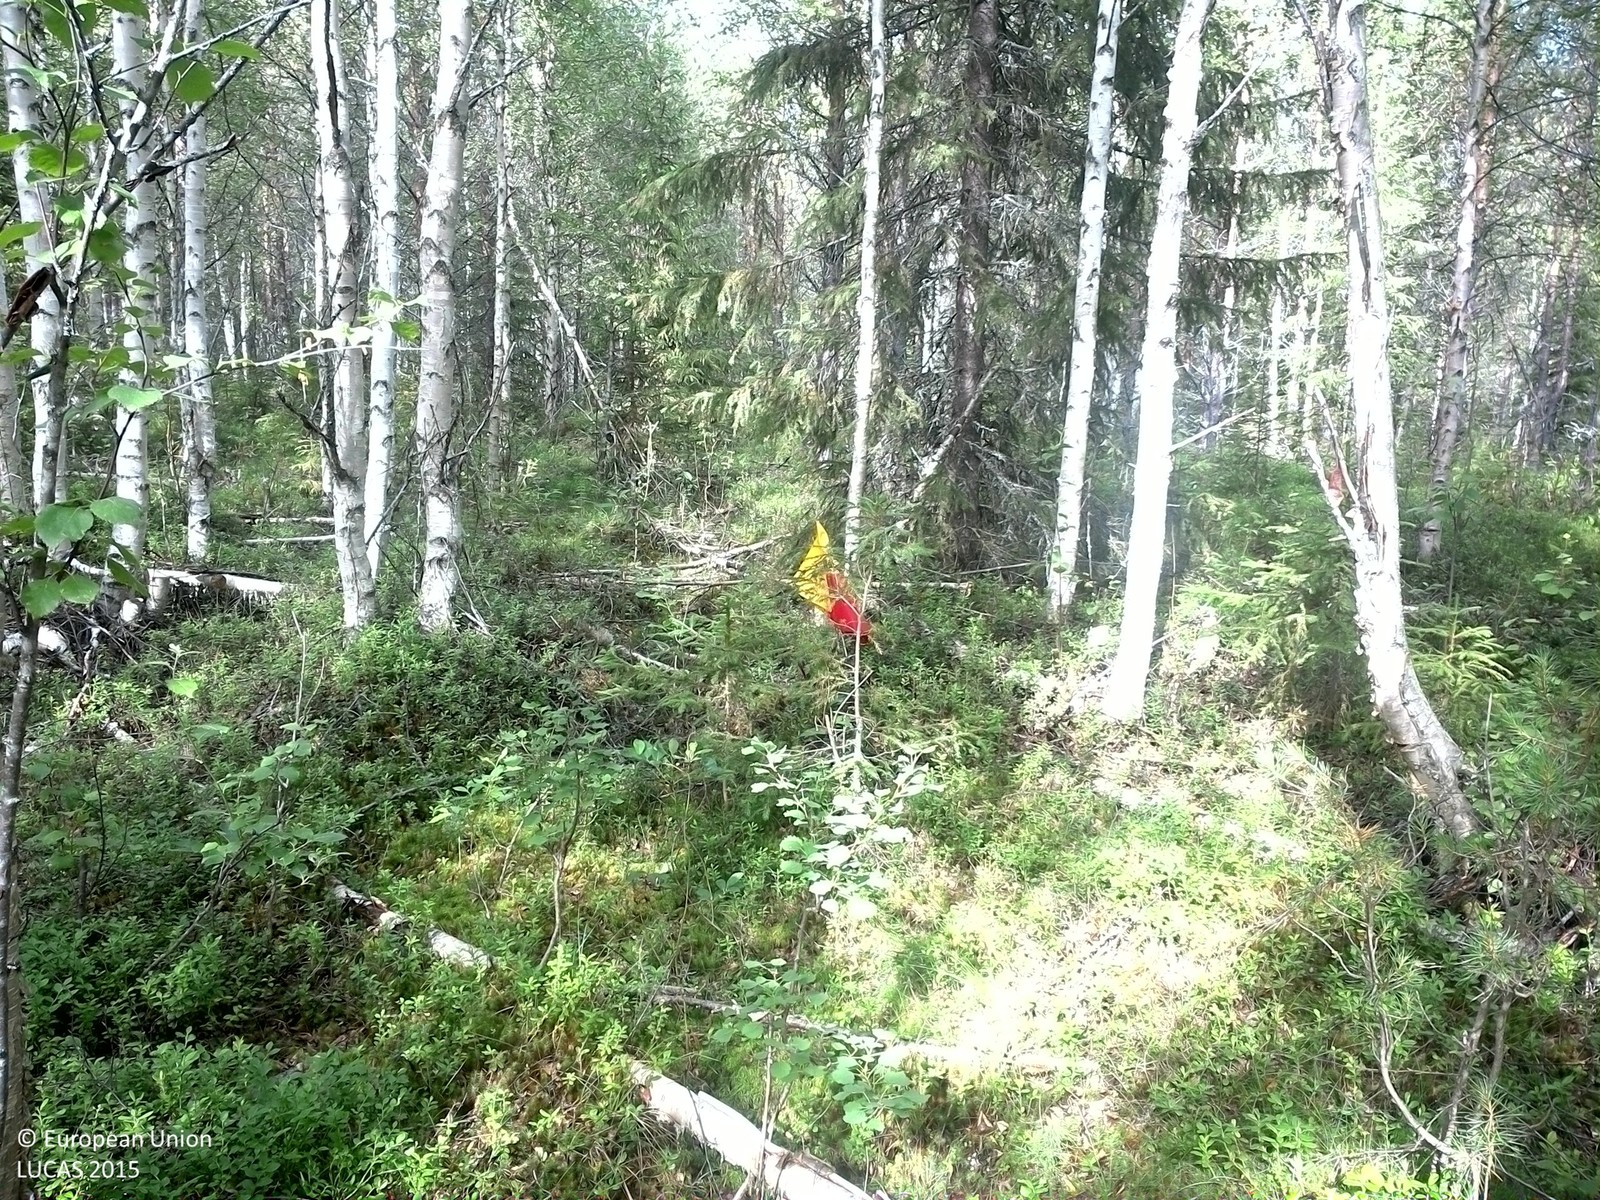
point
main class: Woodland
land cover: Other mixed woodland
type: boreal forest
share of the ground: 50 - 75 %
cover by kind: broadleaved forest trees 45 %, shrubs 25 %, coniferous forest trees 20 %, lichens and mosses 10 %
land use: Forestry
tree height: > 5 m
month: August
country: SE
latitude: 63.6765
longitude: 16.7034
